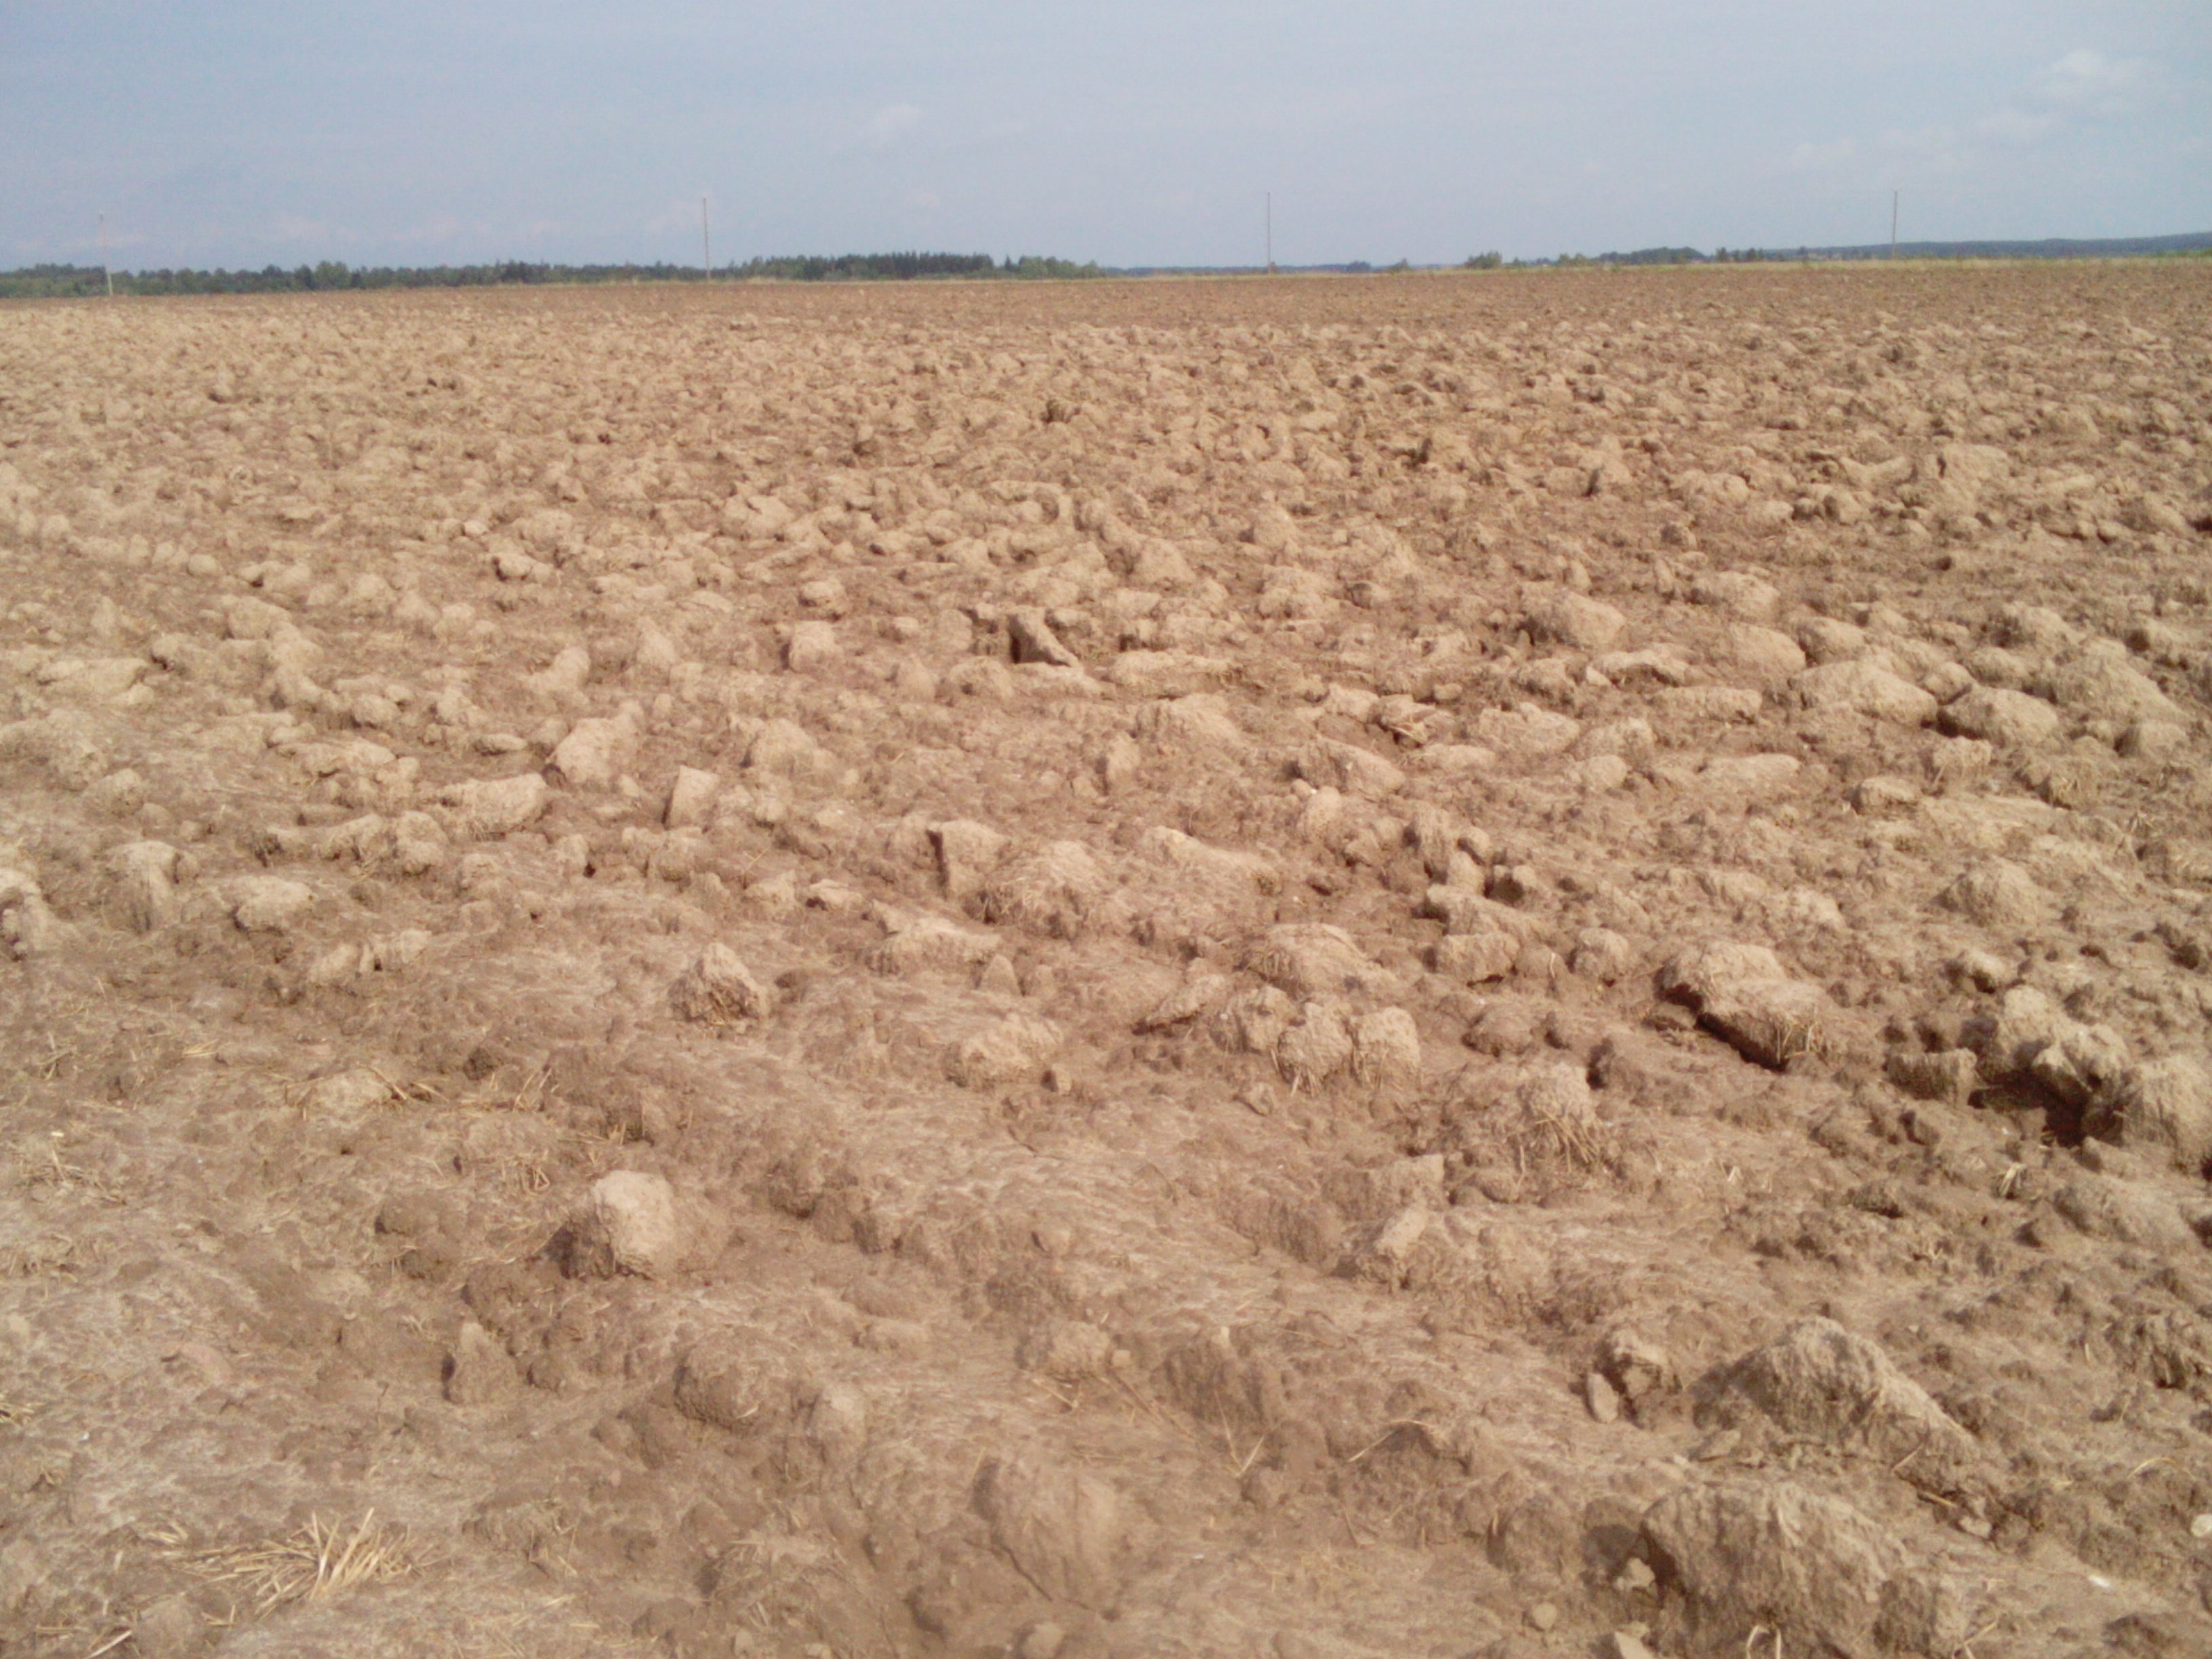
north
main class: Cropland
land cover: Dry pulses
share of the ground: < 10 %
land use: Agriculture (excluding fallow land and kitchen gardens)
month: September
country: LT
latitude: 55.7862
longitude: 22.7417
